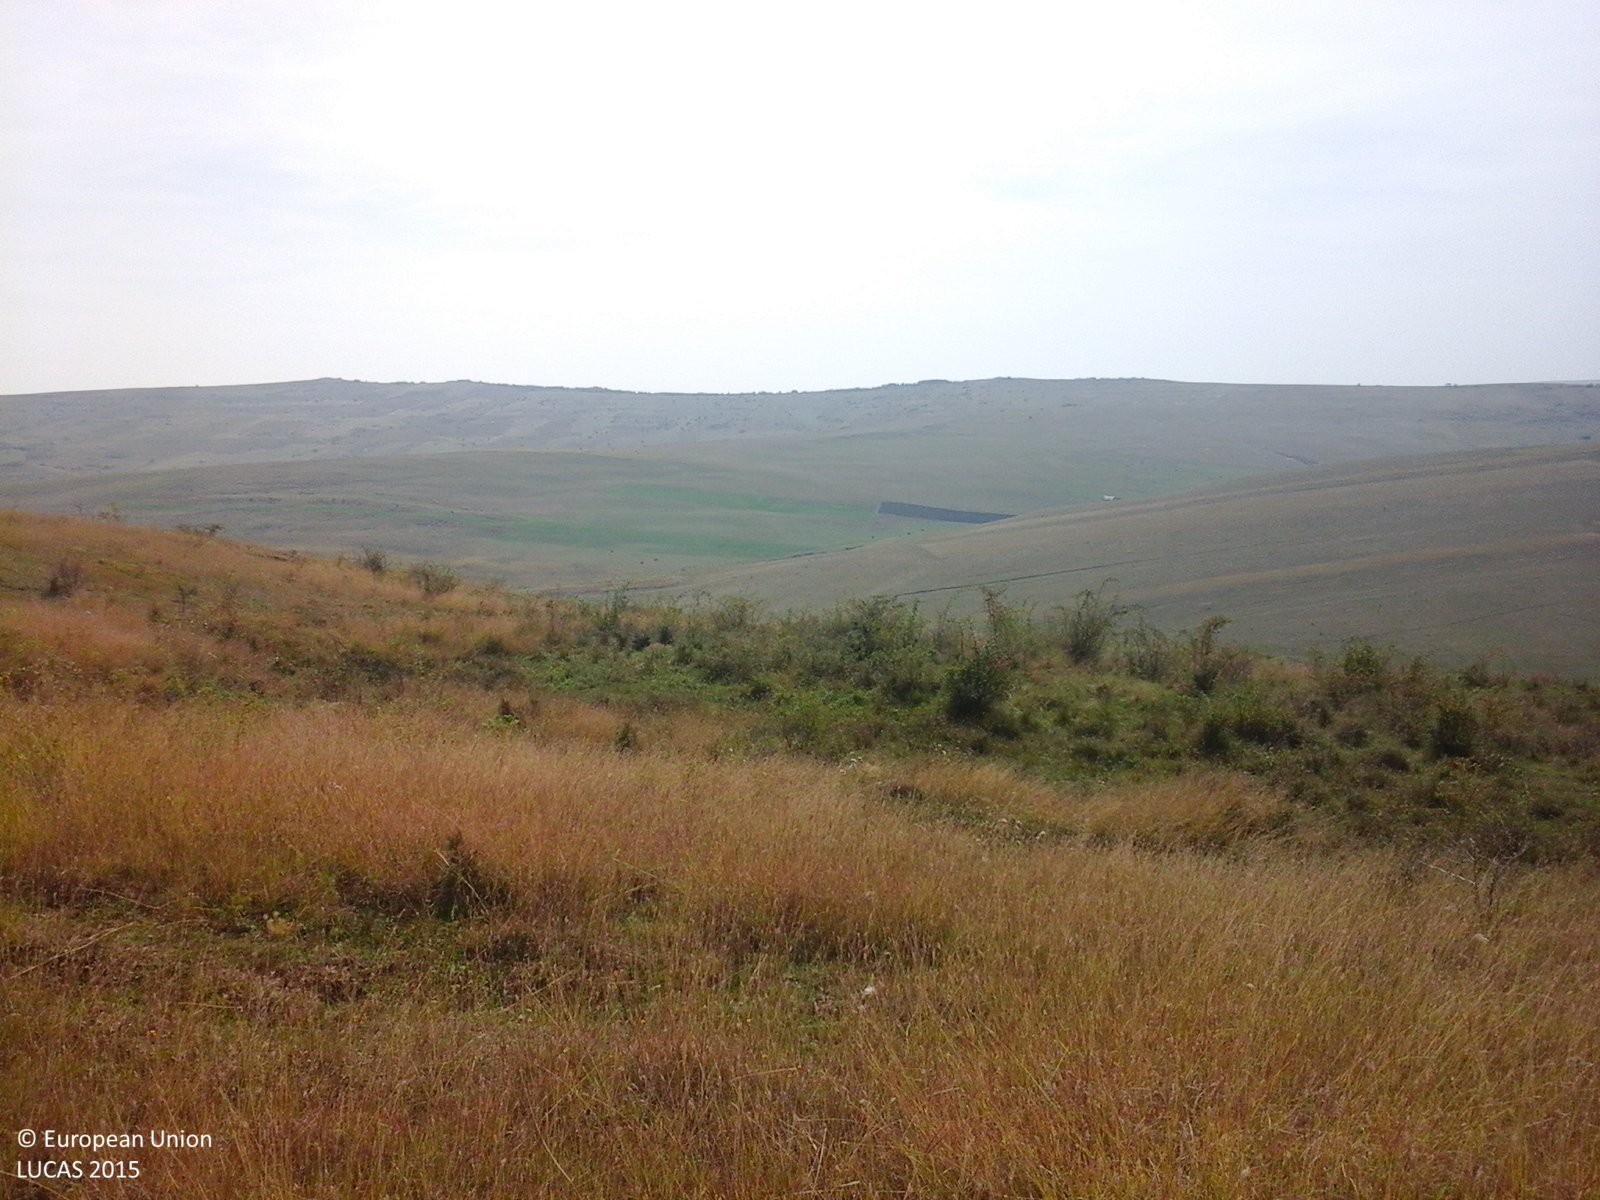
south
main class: Grassland
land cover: Grassland with sparse tree/shrub cover
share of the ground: > 75 %
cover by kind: herbaceous plants 85 %, shrubs 10 %, broadleaved forest trees 5 %
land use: Agriculture (excluding fallow land and kitchen gardens)
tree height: < 5 m
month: September
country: RO
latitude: 46.9084
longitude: 23.6882
